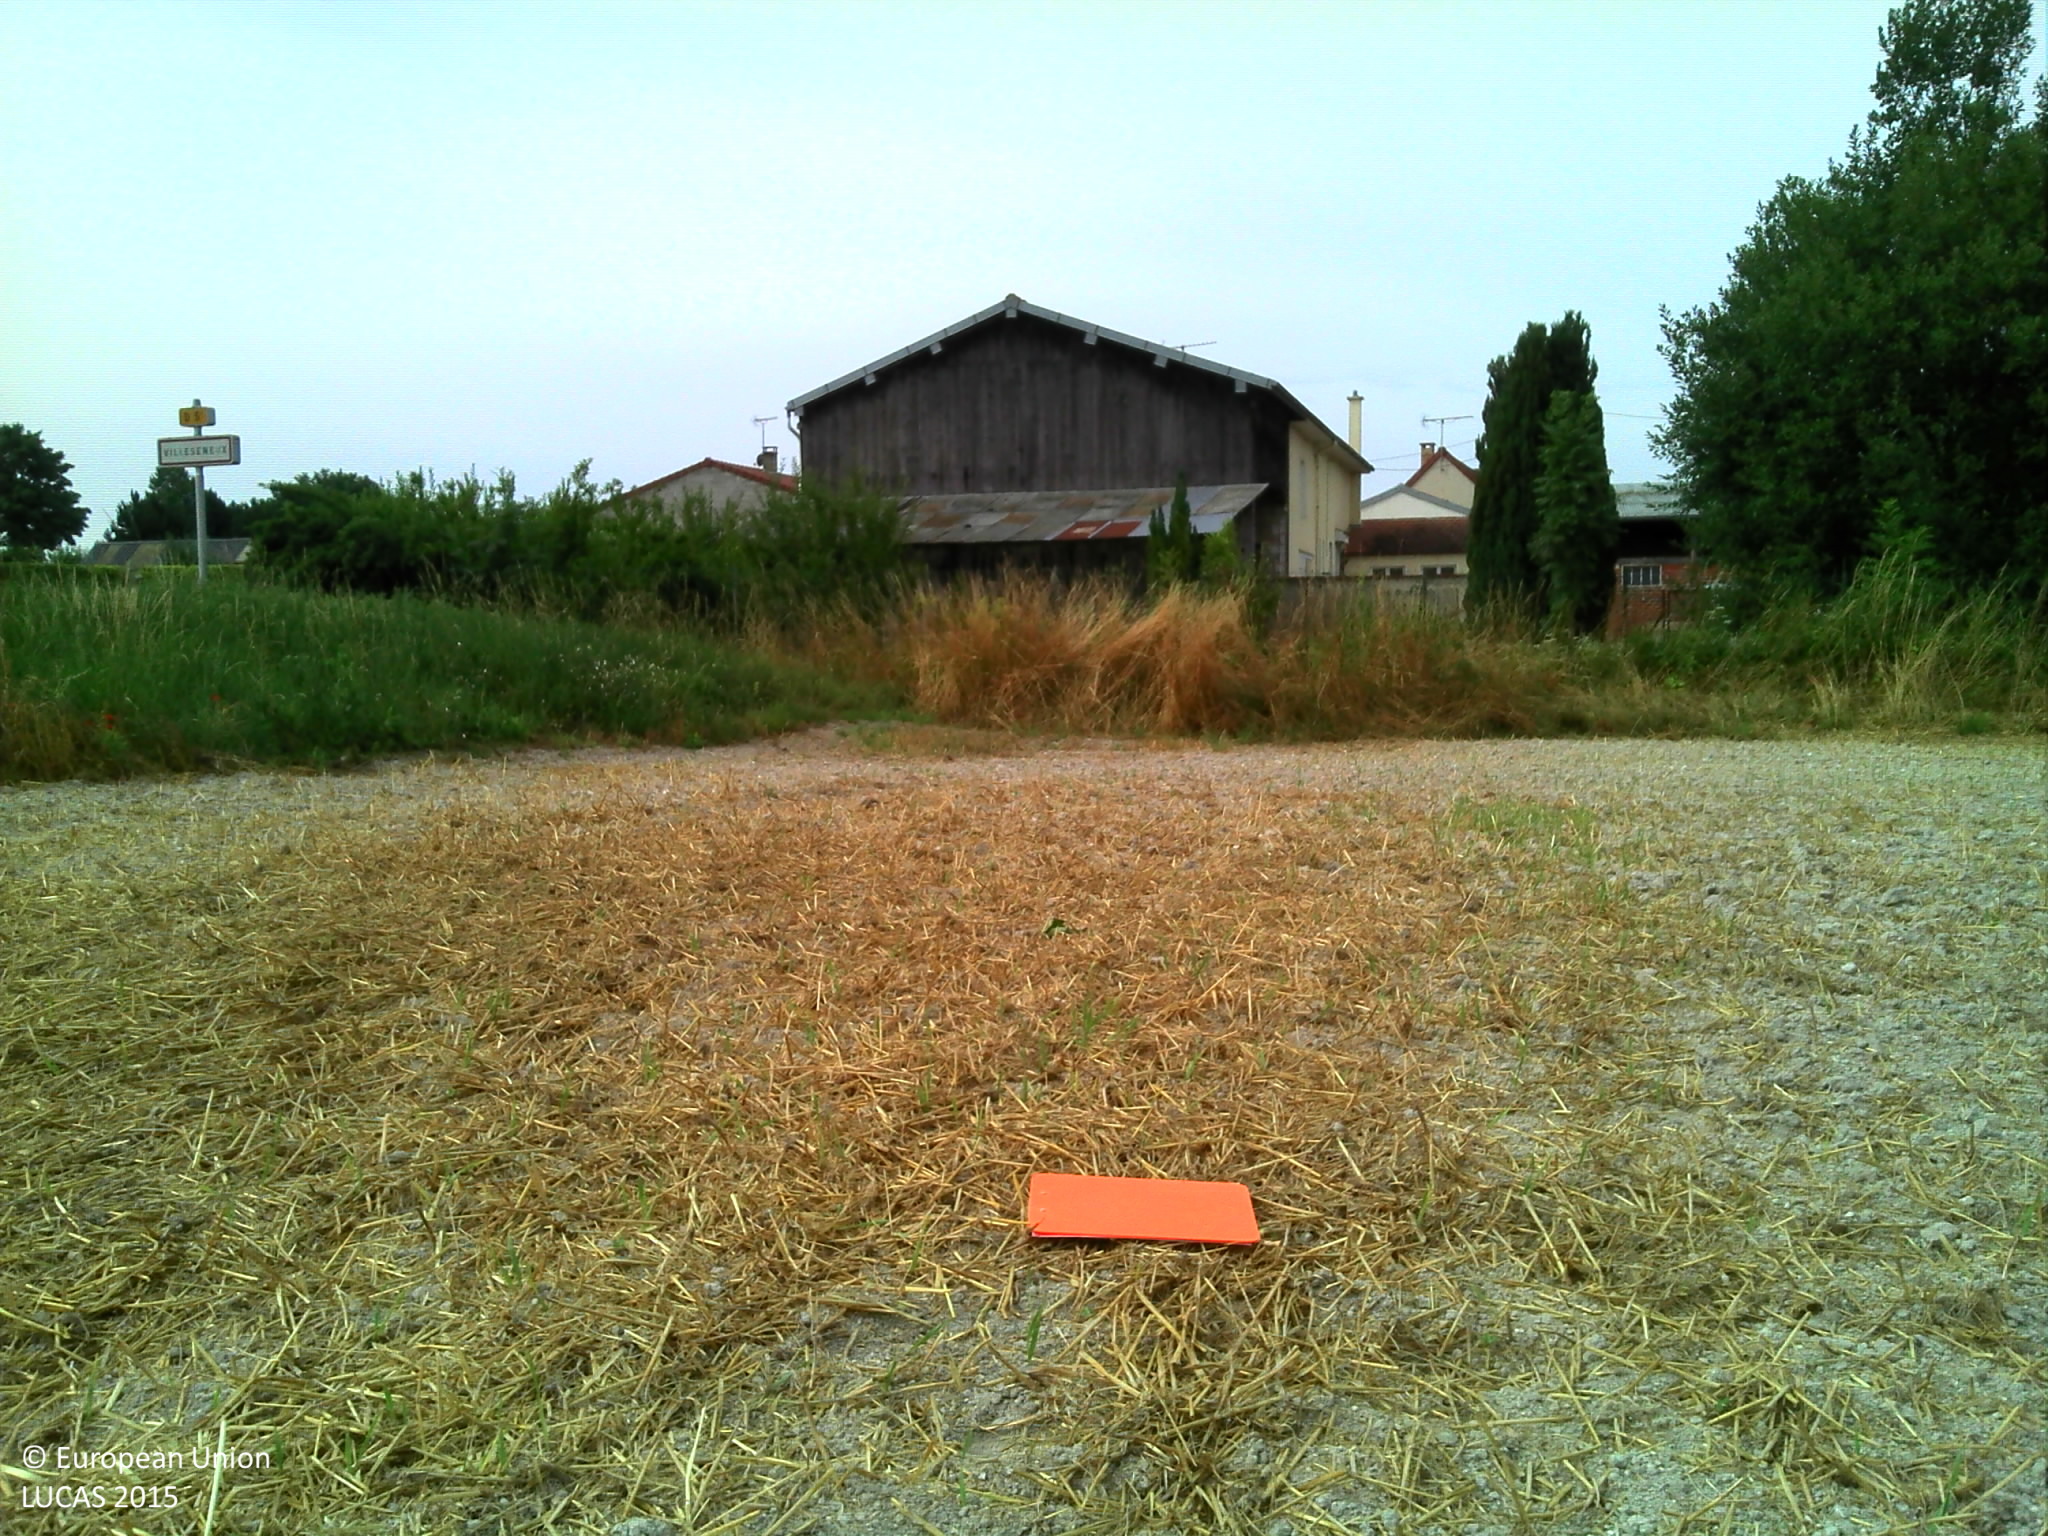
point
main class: Cropland
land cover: Barley
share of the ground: > 75 %
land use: Agriculture (excluding fallow land and kitchen gardens)
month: July
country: FR
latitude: 48.8439
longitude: 4.1501
